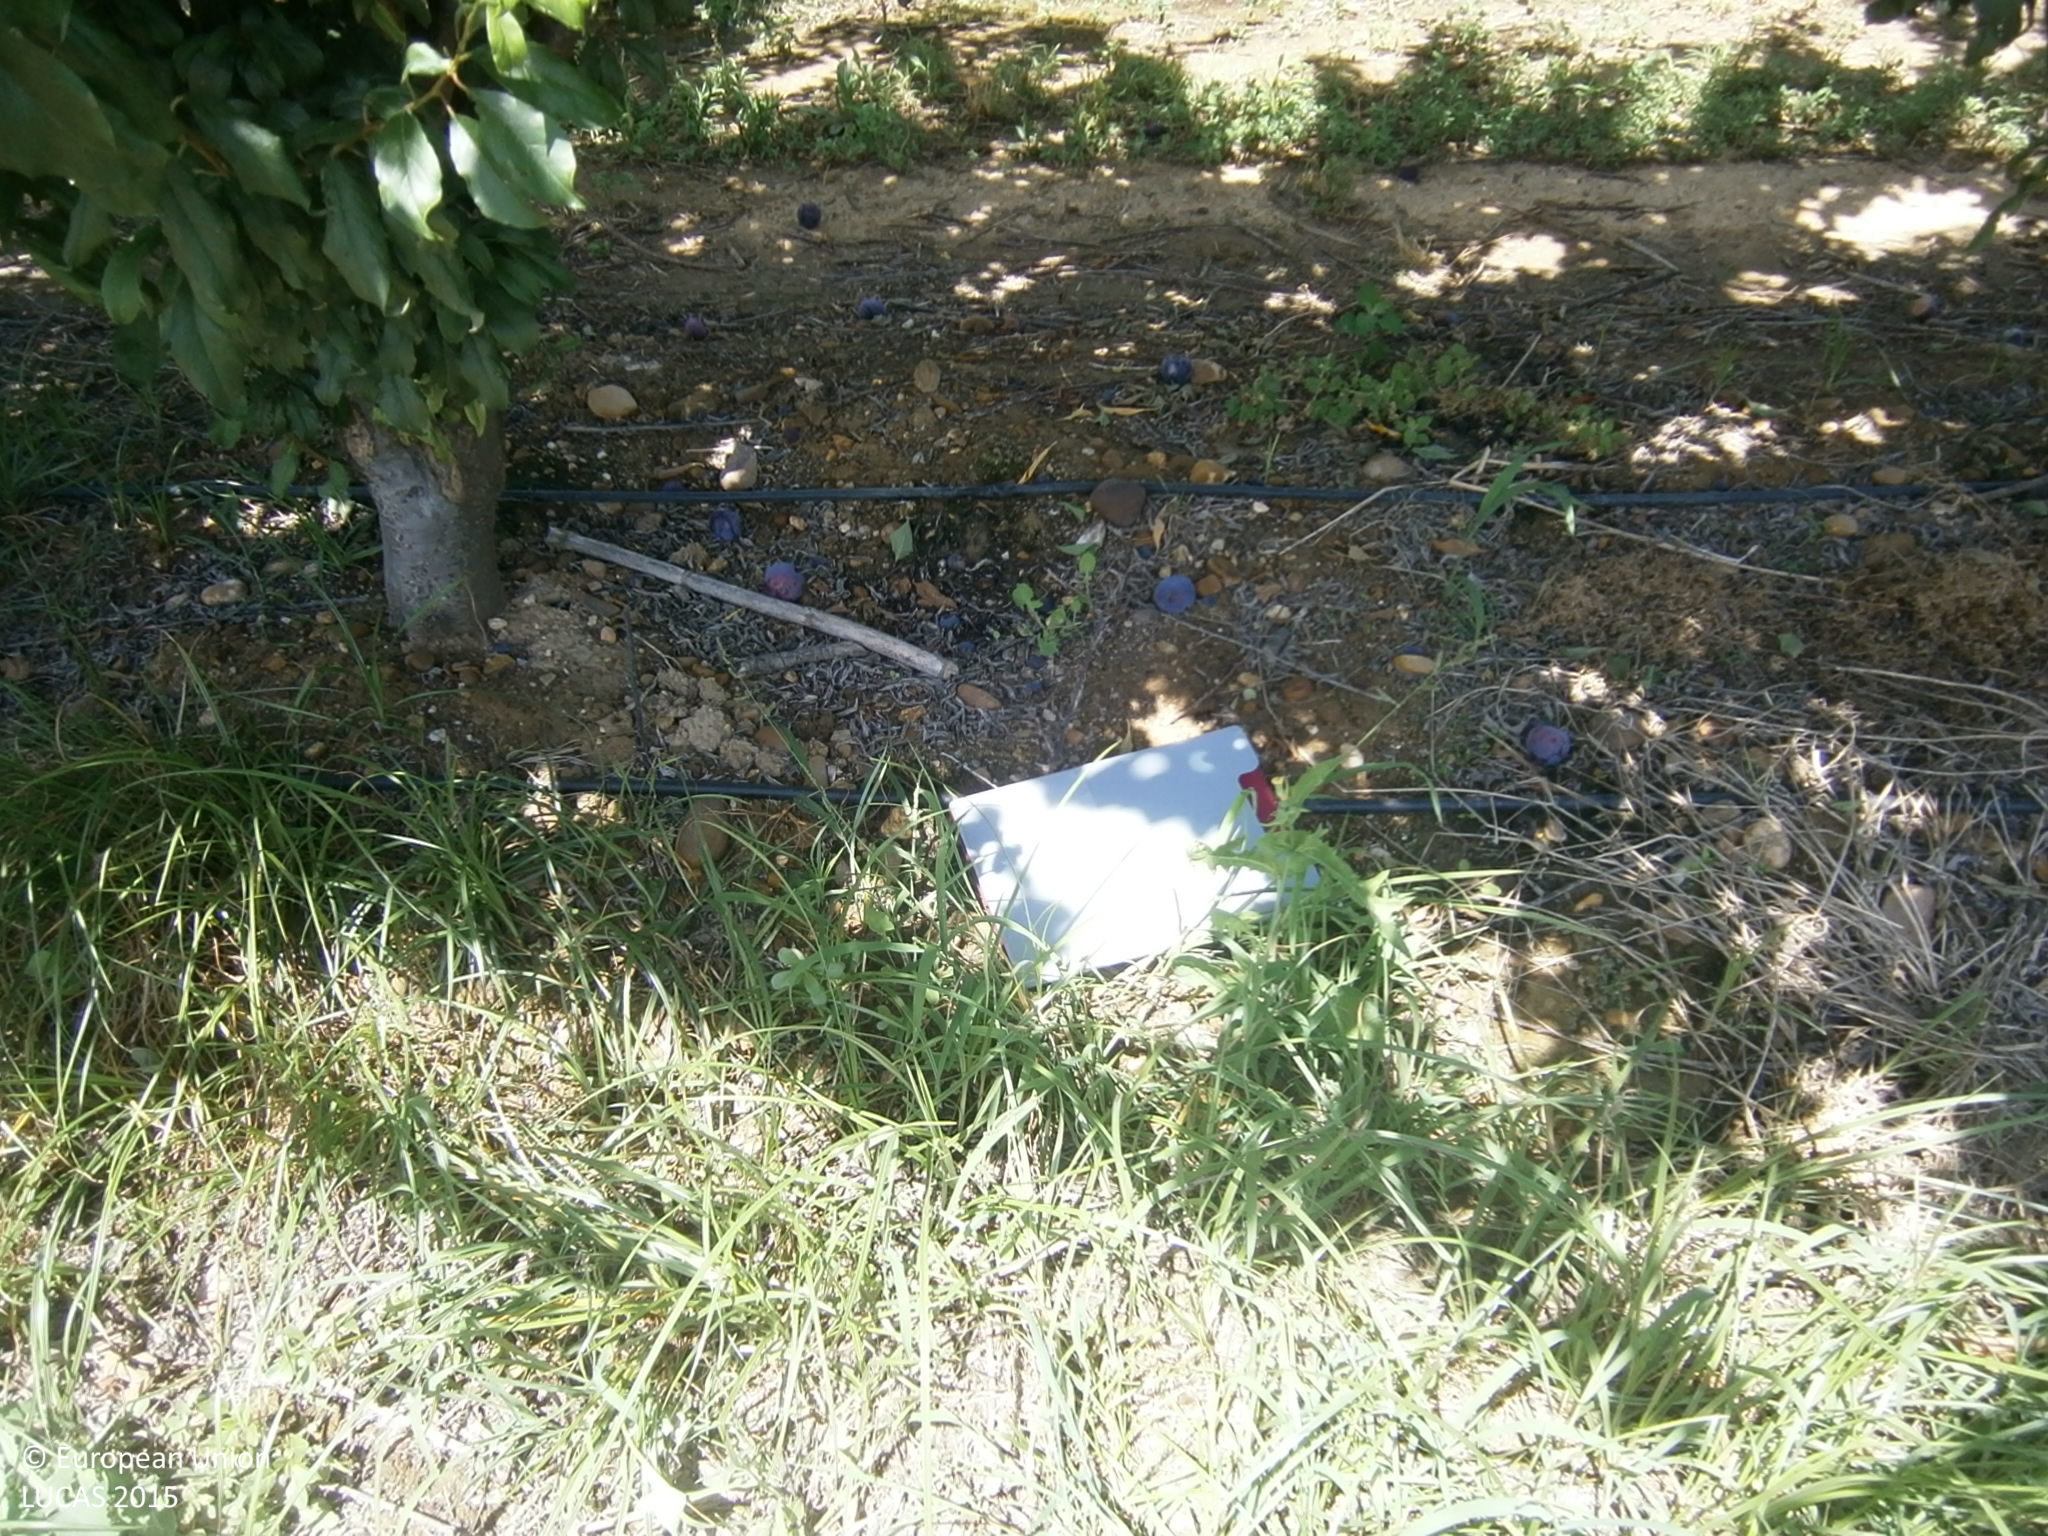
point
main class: Cropland
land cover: Other fruit trees and berries
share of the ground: > 75 %
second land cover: Spontaneously vegetated surfaces
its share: 10 - 25 %
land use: Agriculture (excluding fallow land and kitchen gardens)
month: June
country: ES
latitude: 38.9018
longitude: -6.6800
